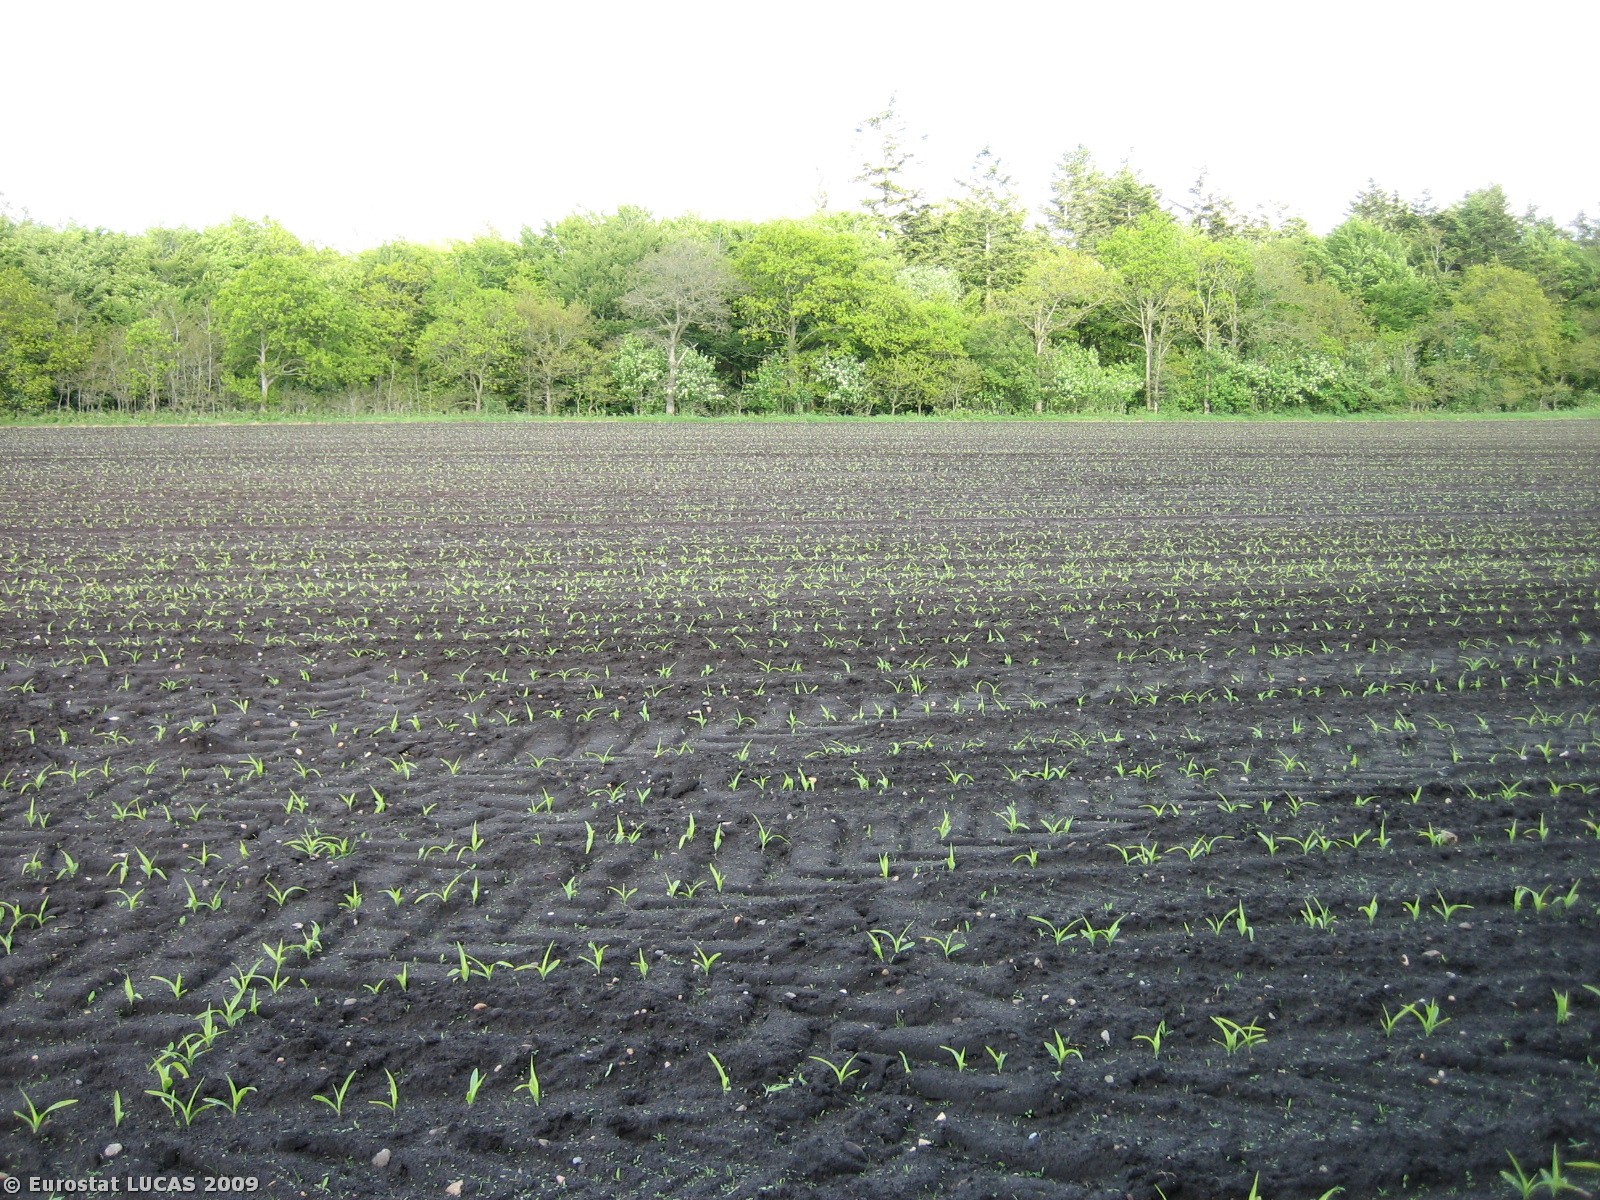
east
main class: Cropland
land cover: Maize
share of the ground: < 10 %
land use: Agriculture (excluding fallow land and kitchen gardens)
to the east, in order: Maize; Broadleaved woodland; Tracks; Broadleaved woodland; Tracks; Mixed woodland; Coniferous woodland; Tracks; Coniferous woodland
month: May
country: DK
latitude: 56.2354
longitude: 8.7270
